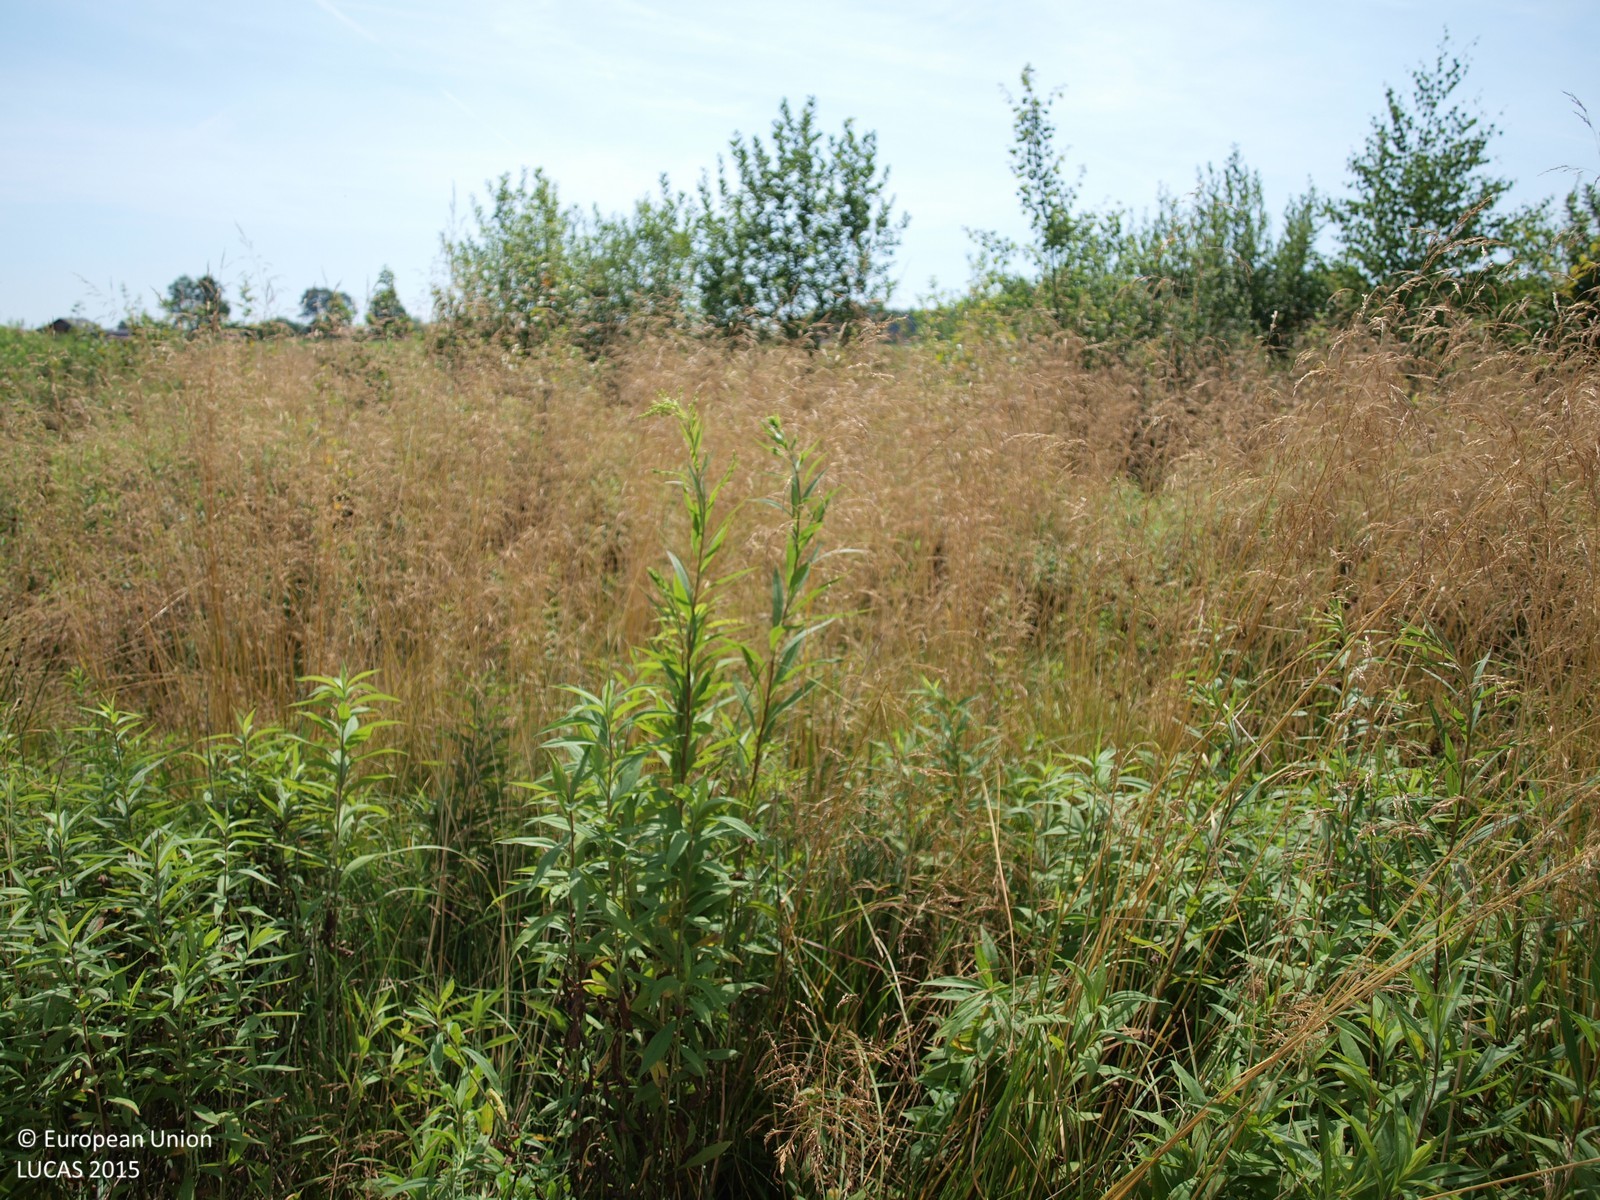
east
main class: Grassland
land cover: Grassland with sparse tree/shrub cover
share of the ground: > 75 %
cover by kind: herbaceous plants 90 %, broadleaved forest trees 5 %, shrubs 5 %
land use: Fallow land
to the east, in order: Grassland with sparse tree/shrub cover; Oats; Tracks; Ditches and canals; Tracks; Oats; Shrubland with sparse tree cover
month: July
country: HR
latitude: 45.7399
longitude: 15.8452
